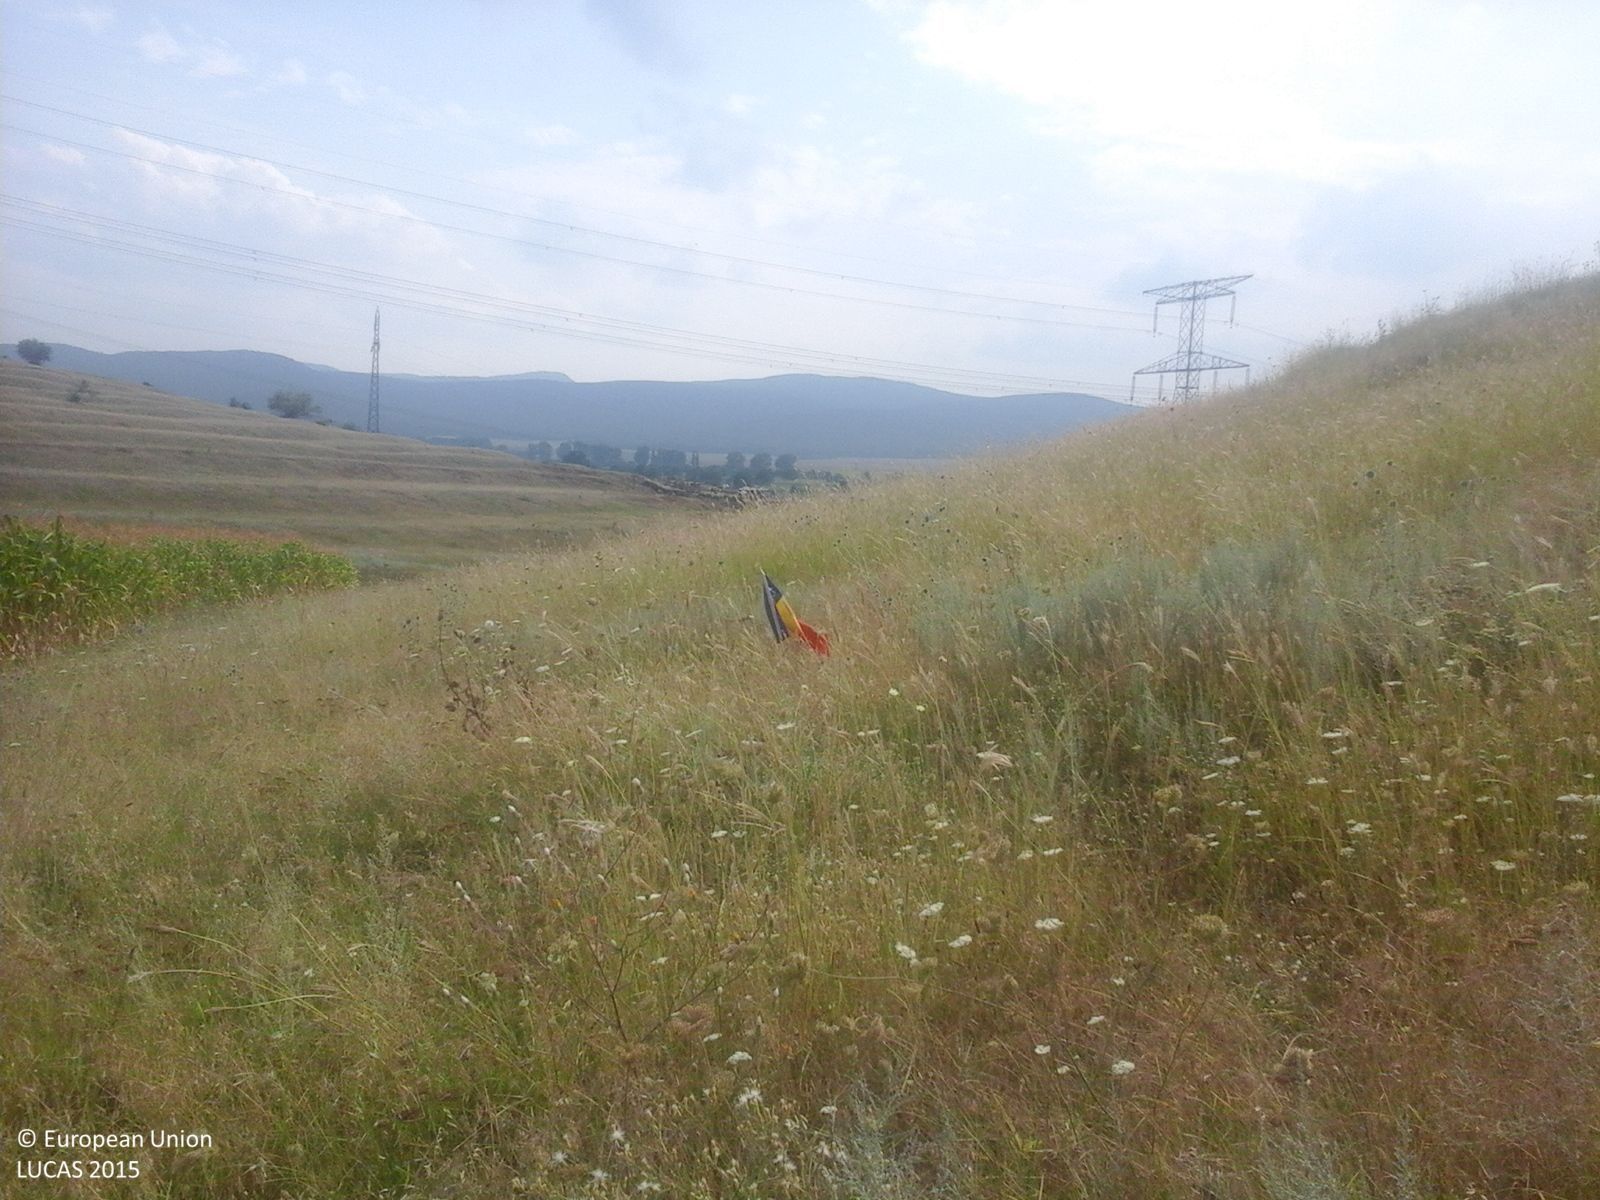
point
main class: Grassland
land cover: Grassland without tree/shrub cover
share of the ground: > 75 %
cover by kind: herbaceous plants 100 %
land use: Agriculture (excluding fallow land and kitchen gardens)
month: July
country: RO
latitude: 45.2735
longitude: 28.2887
